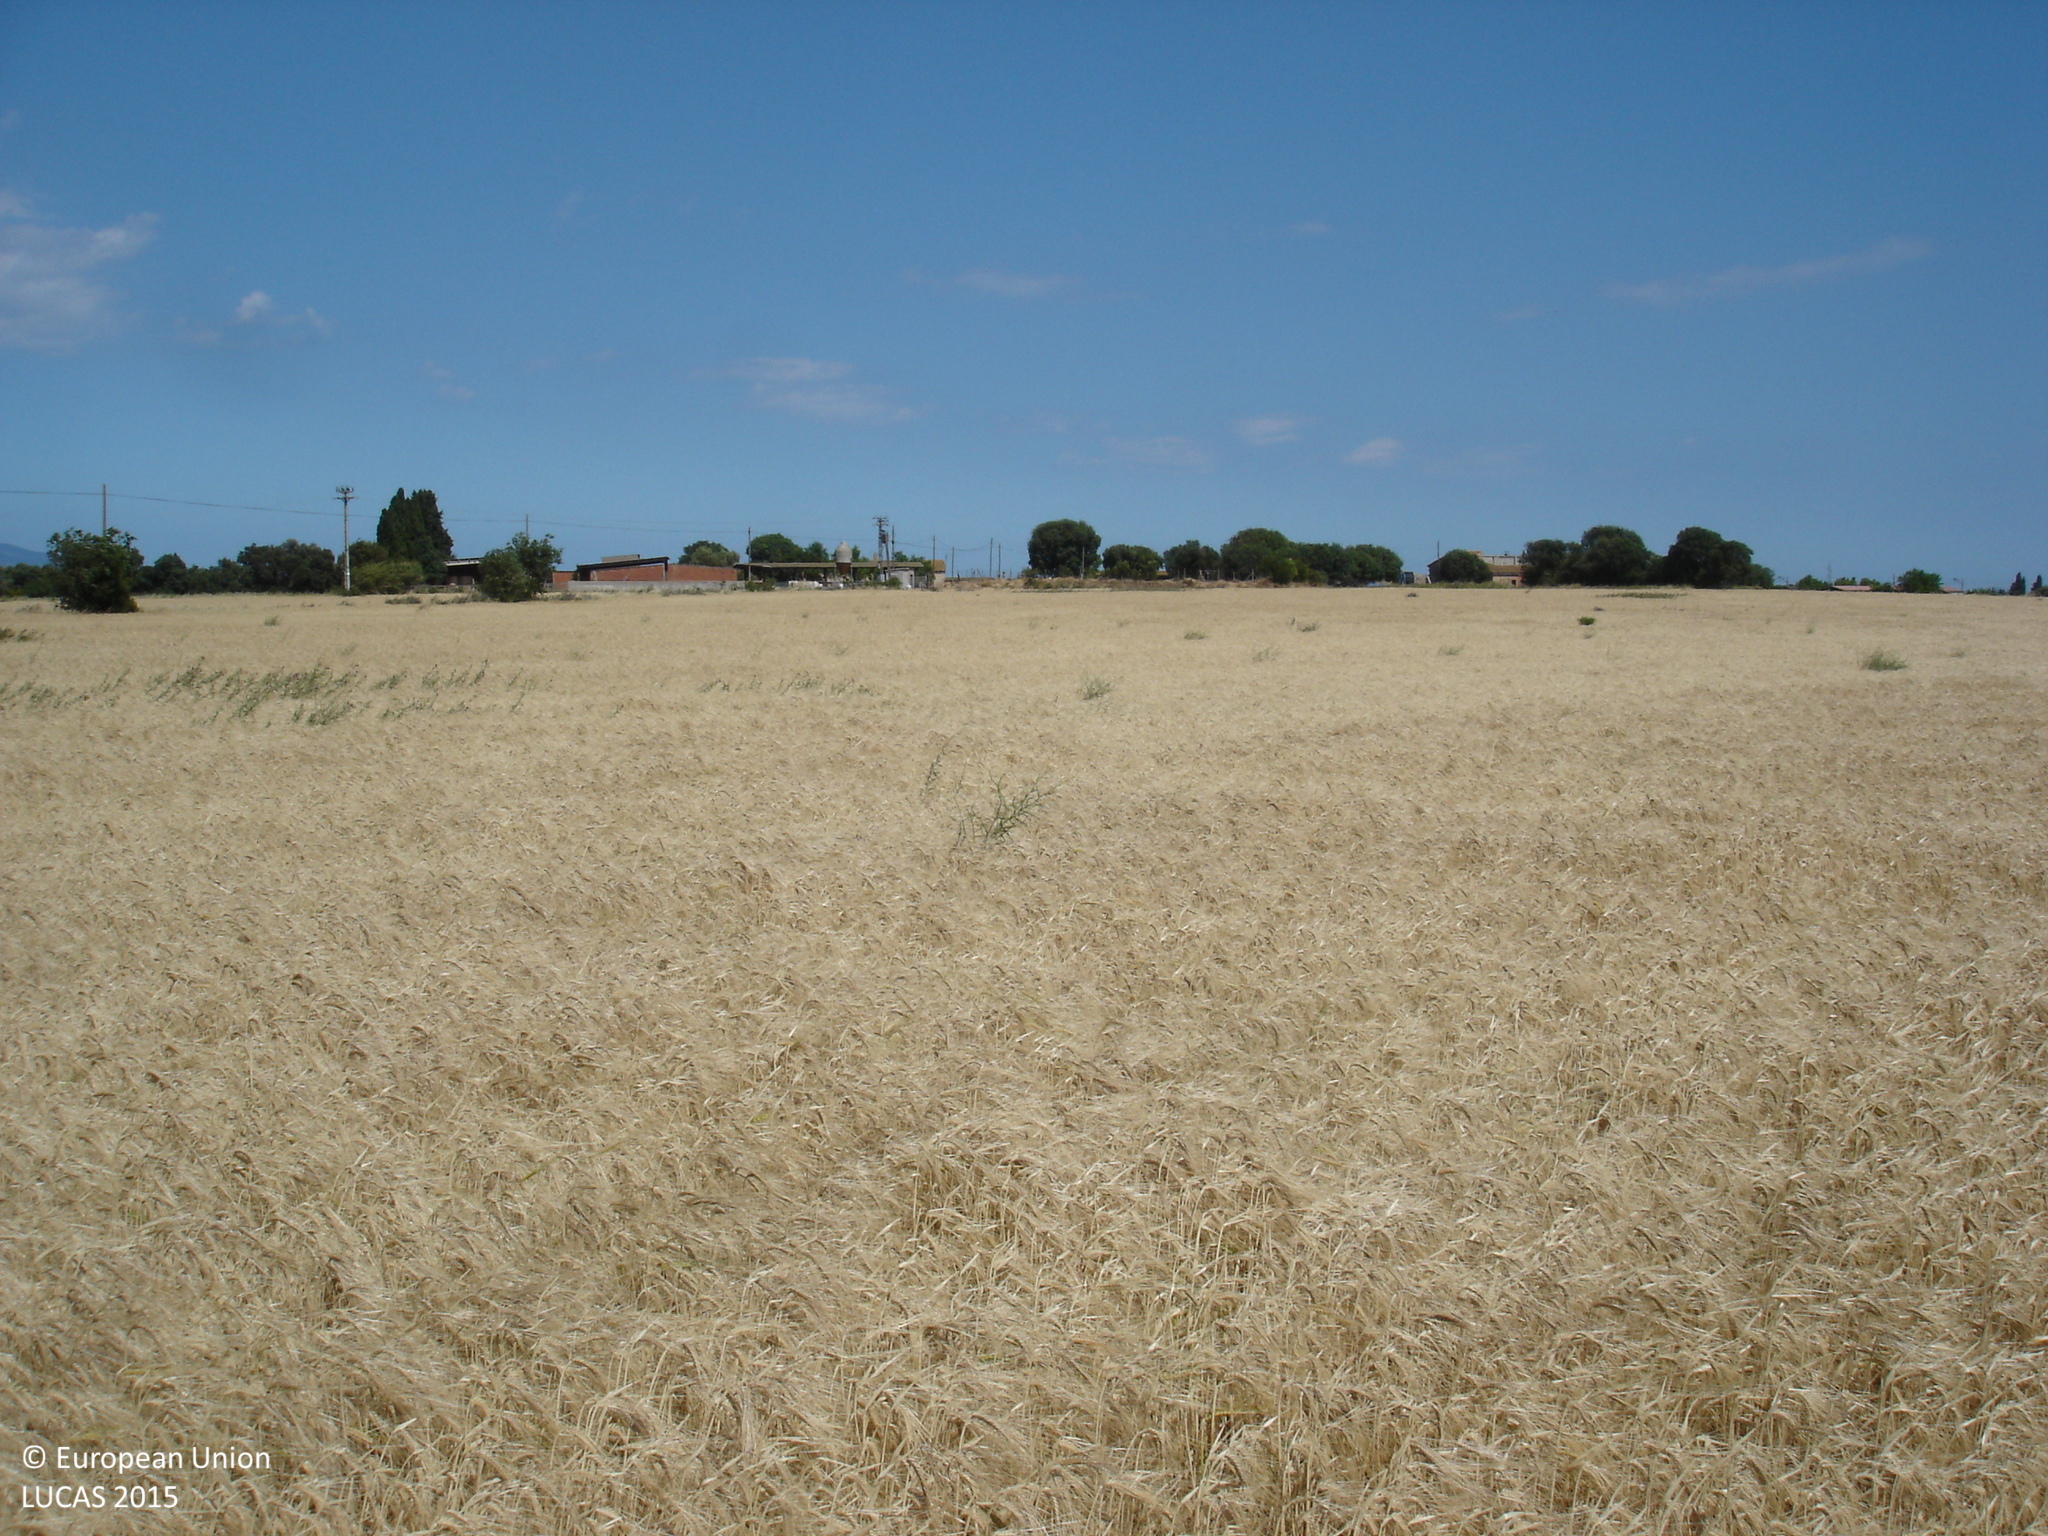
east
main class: Cropland
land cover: Barley
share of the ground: > 75 %
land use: Agriculture (excluding fallow land and kitchen gardens)
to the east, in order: Barley
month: May
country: ES
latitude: 42.1927
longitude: 2.9791
